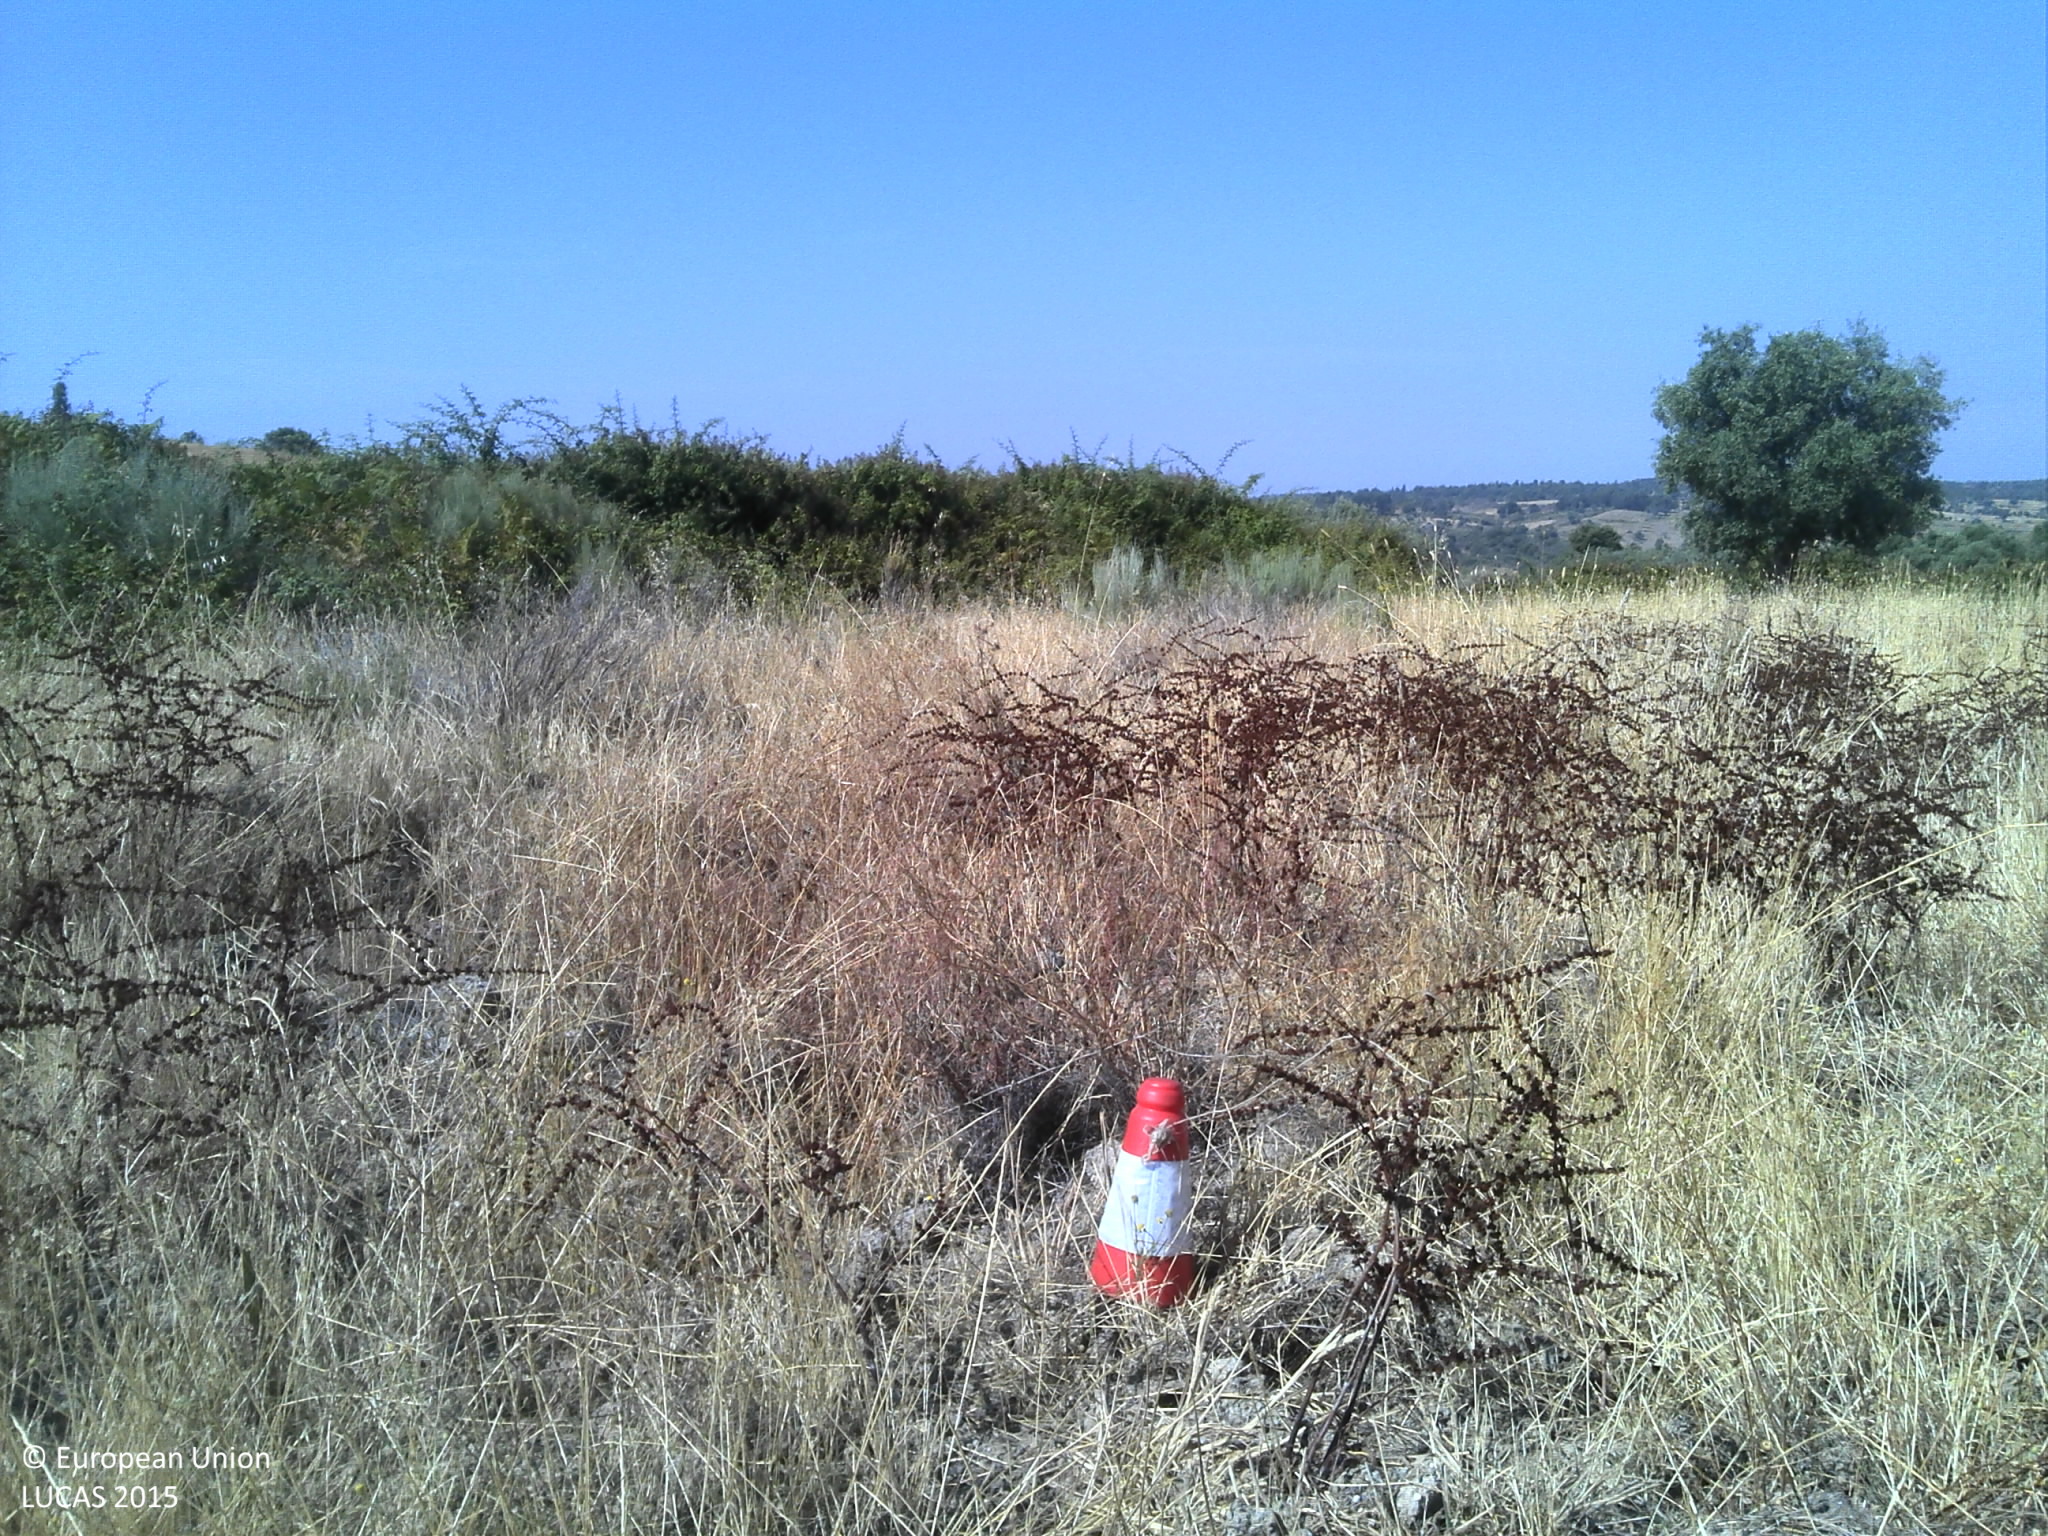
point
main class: Grassland
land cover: Grassland without tree/shrub cover
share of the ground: 50 - 75 %
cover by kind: herbaceous plants 65 %, unconsolidated bare surface 35 %
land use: Agriculture (excluding fallow land and kitchen gardens)
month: July
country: PT
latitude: 39.9953
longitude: -7.3751
